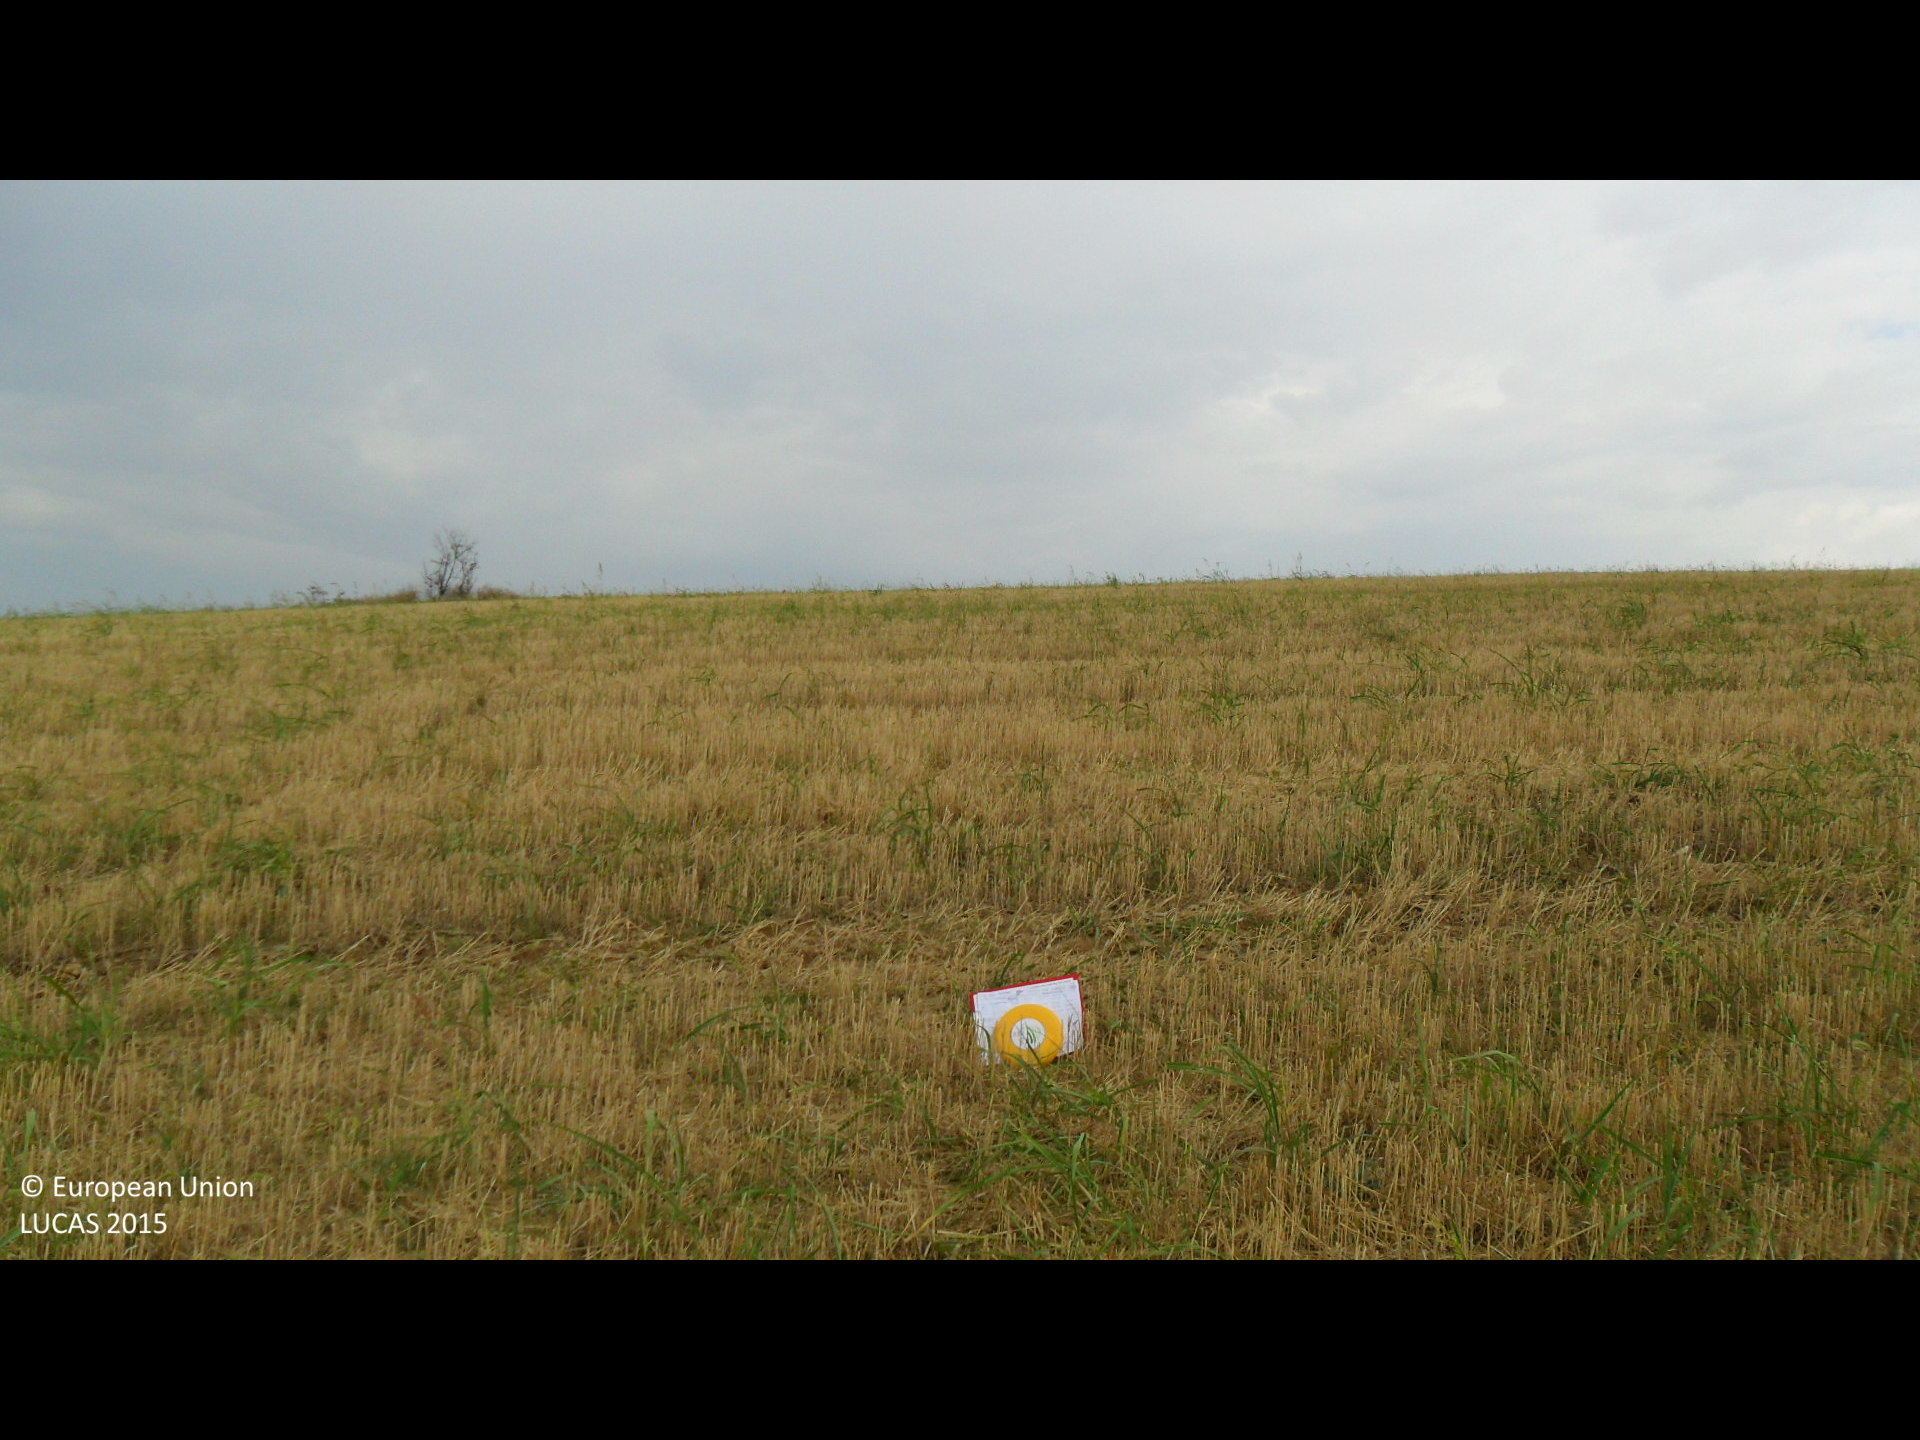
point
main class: Cropland
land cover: Barley
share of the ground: > 75 %
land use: Agriculture (excluding fallow land and kitchen gardens)
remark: Harvested field
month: August
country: BG
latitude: 43.4708
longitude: 26.2042
